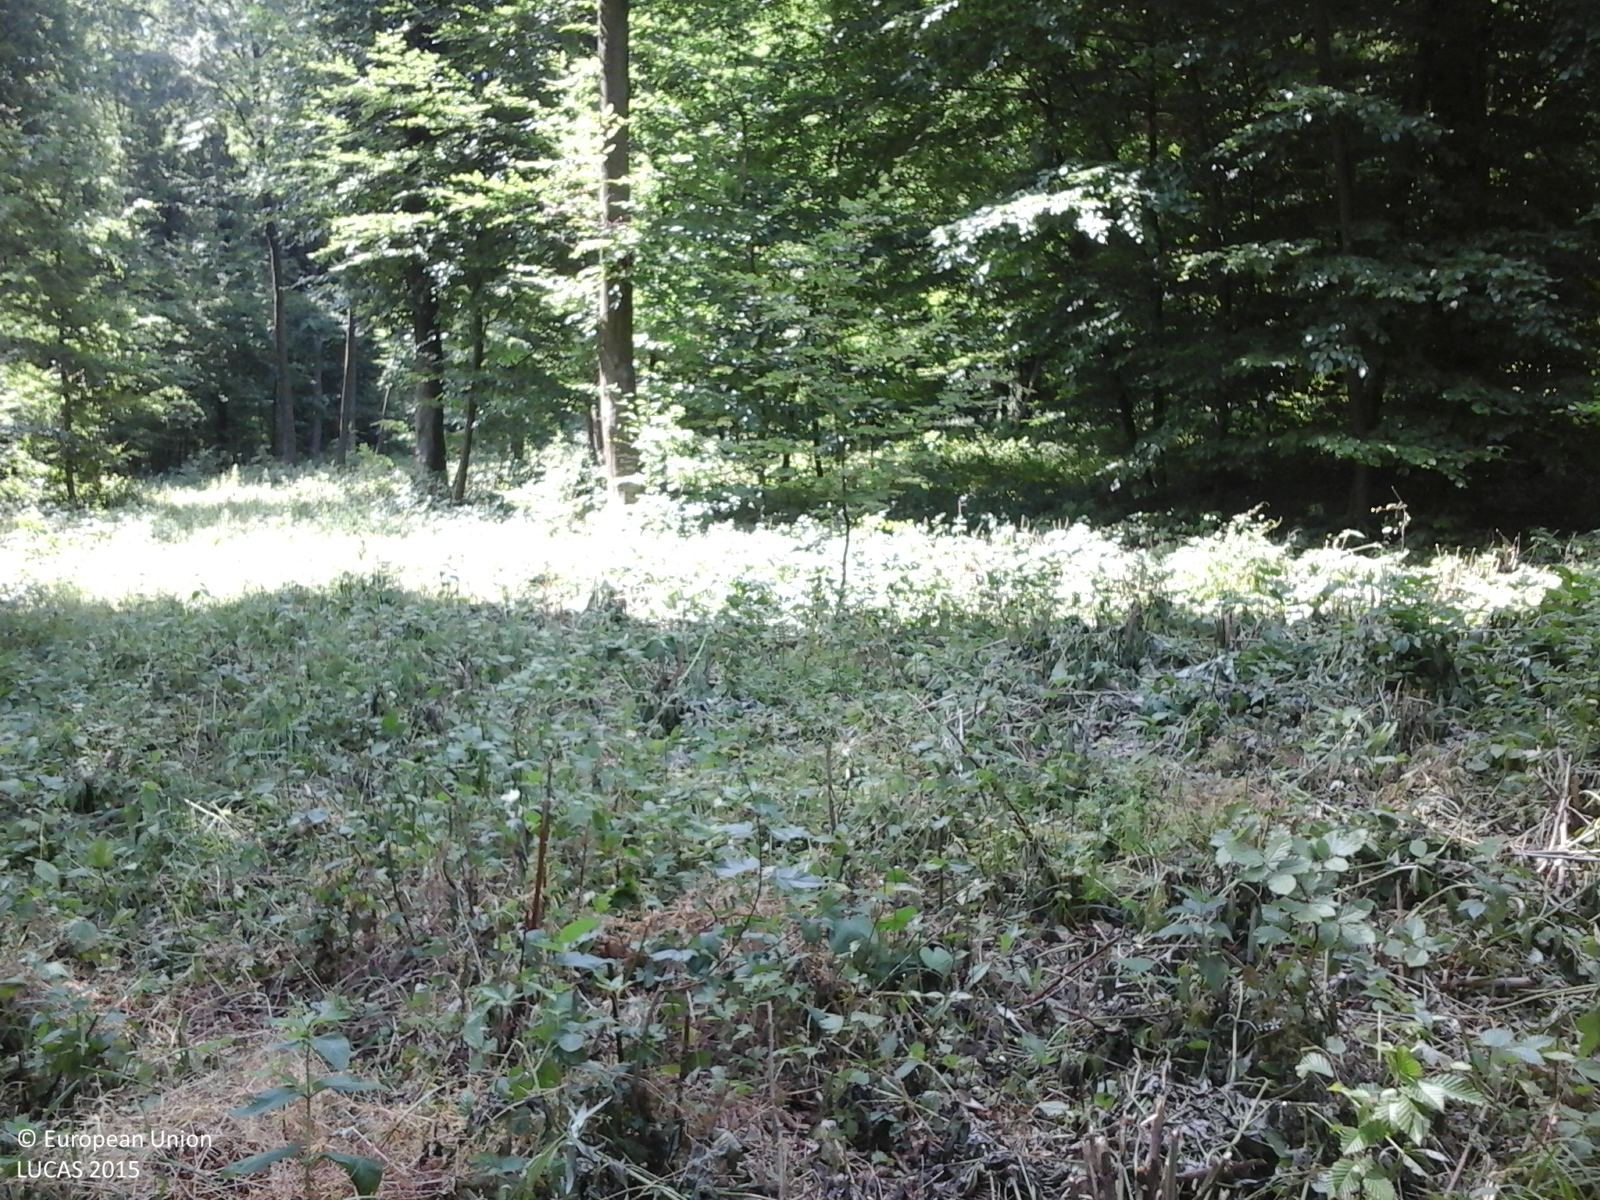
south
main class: Woodland
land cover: Broadleaved woodland
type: beech forest
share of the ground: > 75 %
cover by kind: broadleaved forest trees 90 %, herbaceous plants 10 %
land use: Forestry
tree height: > 5 m
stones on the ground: < 10 %
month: June
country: RO
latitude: 47.1328
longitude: 26.7443
